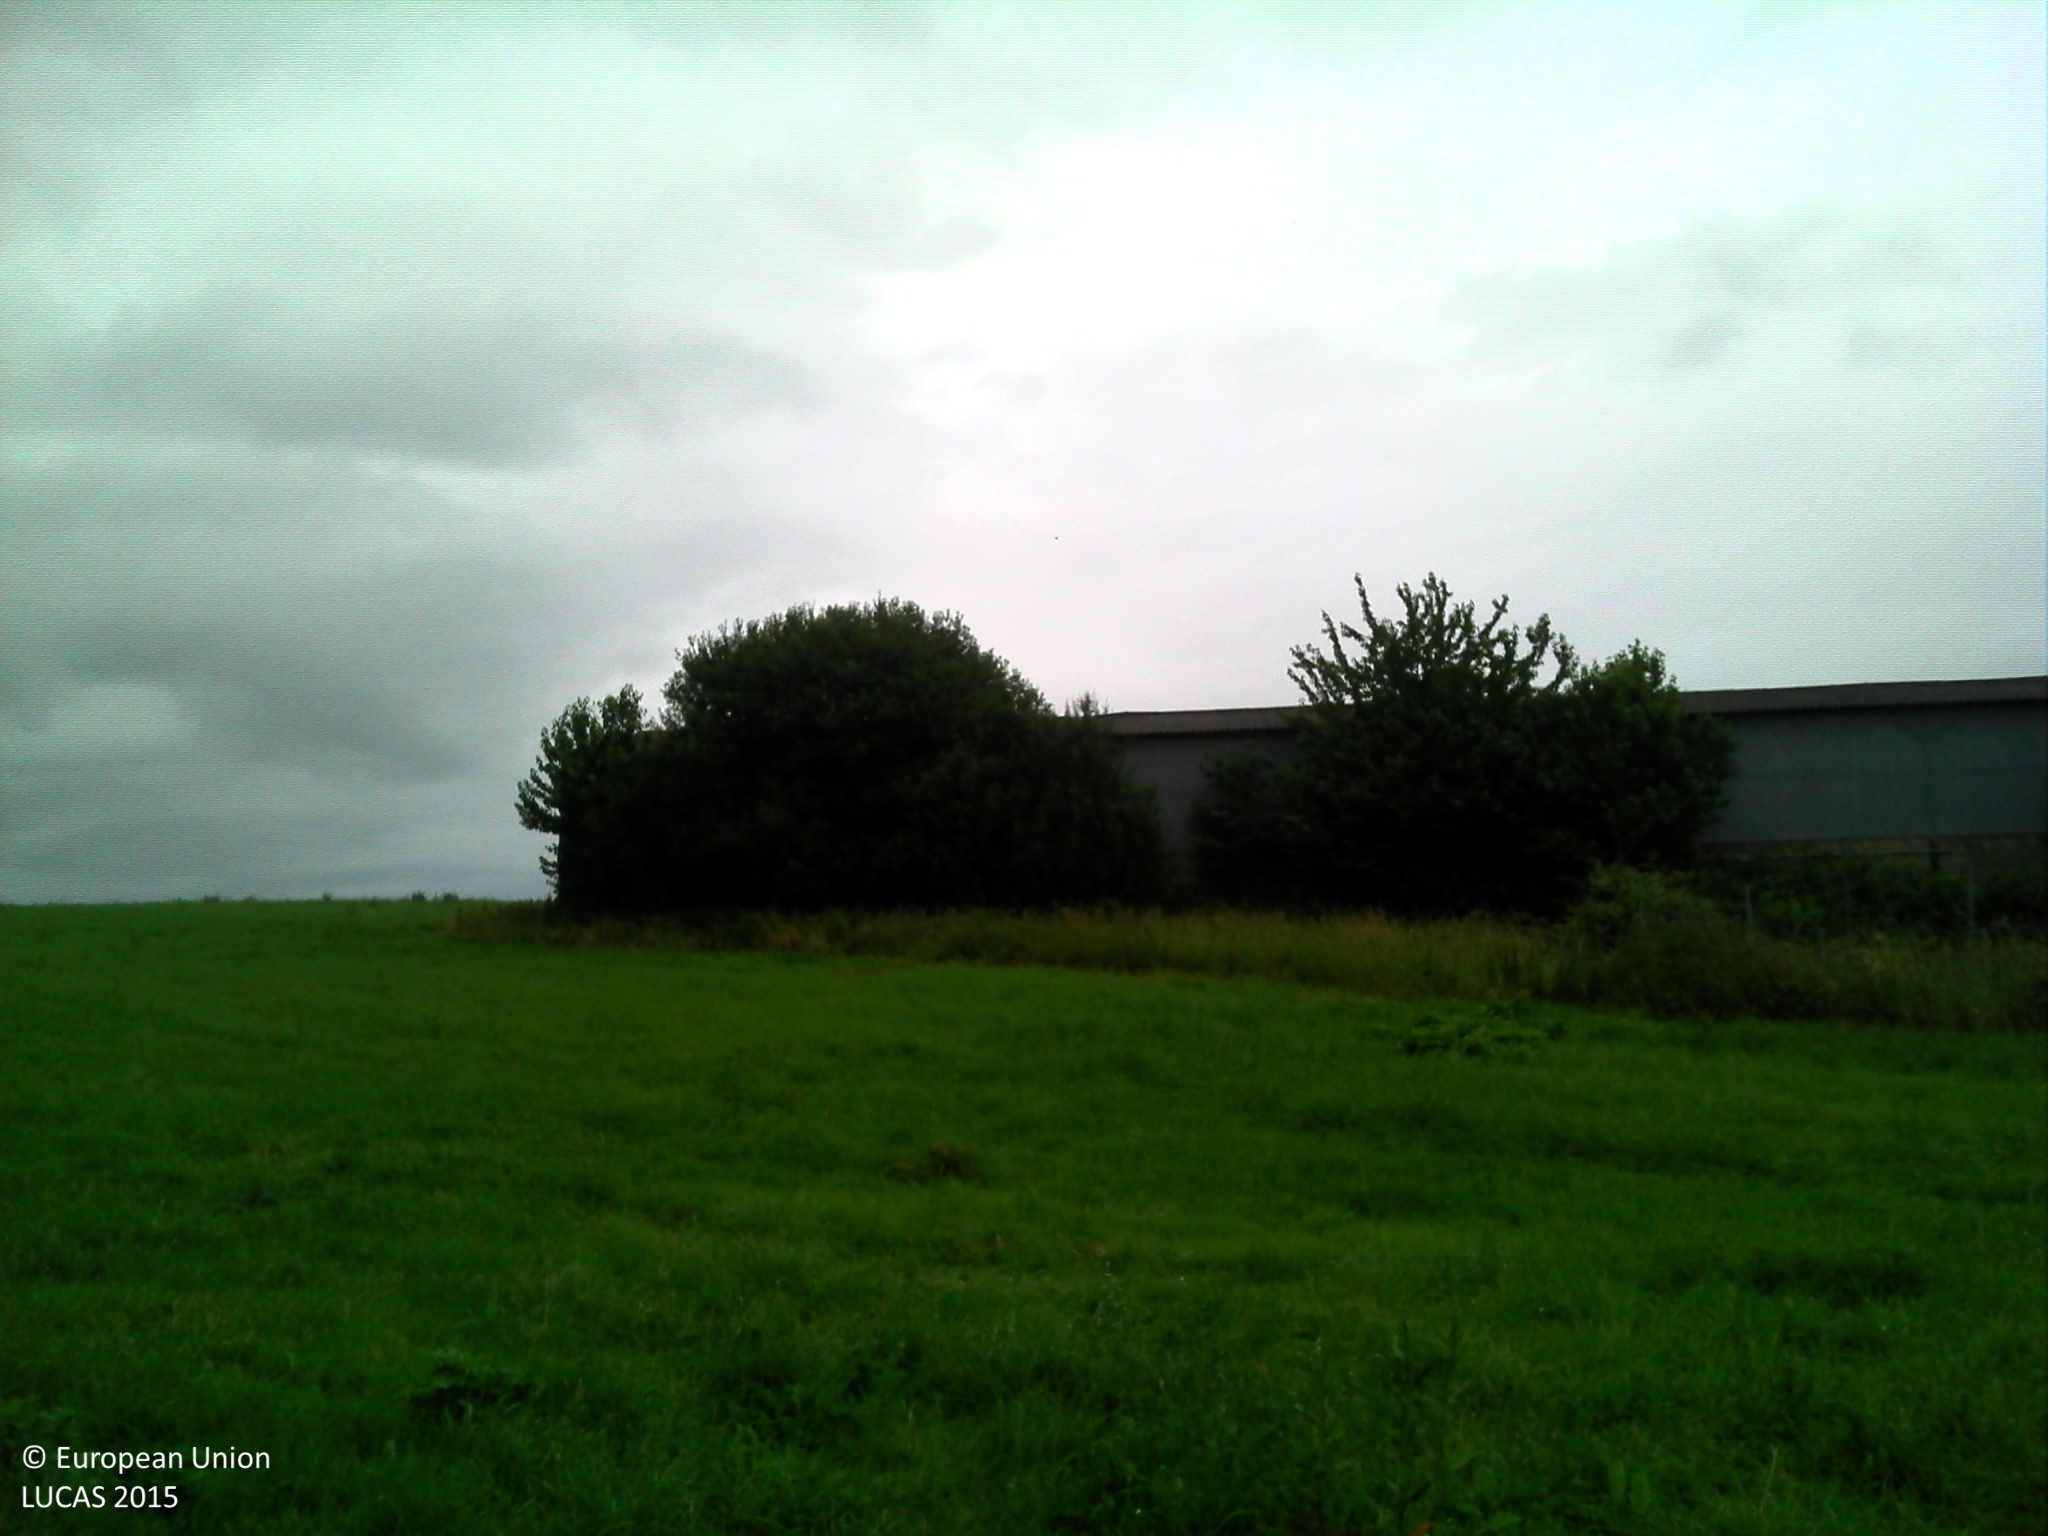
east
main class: Grassland
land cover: Grassland without tree/shrub cover
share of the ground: > 75 %
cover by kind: herbaceous plants 100 %
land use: Agriculture (excluding fallow land and kitchen gardens)
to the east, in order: Grassland without tree/shrub cover; Fences; Single bushes/trees; Artificial constructions in urban areas; Grassland without tree/shrub cover; Fences; Tracks; Grass margins; Ditches and canals; Fences; Grassland without tree/shrub cover; Lucerne
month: June
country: FR
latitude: 48.1640
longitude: 0.1716
